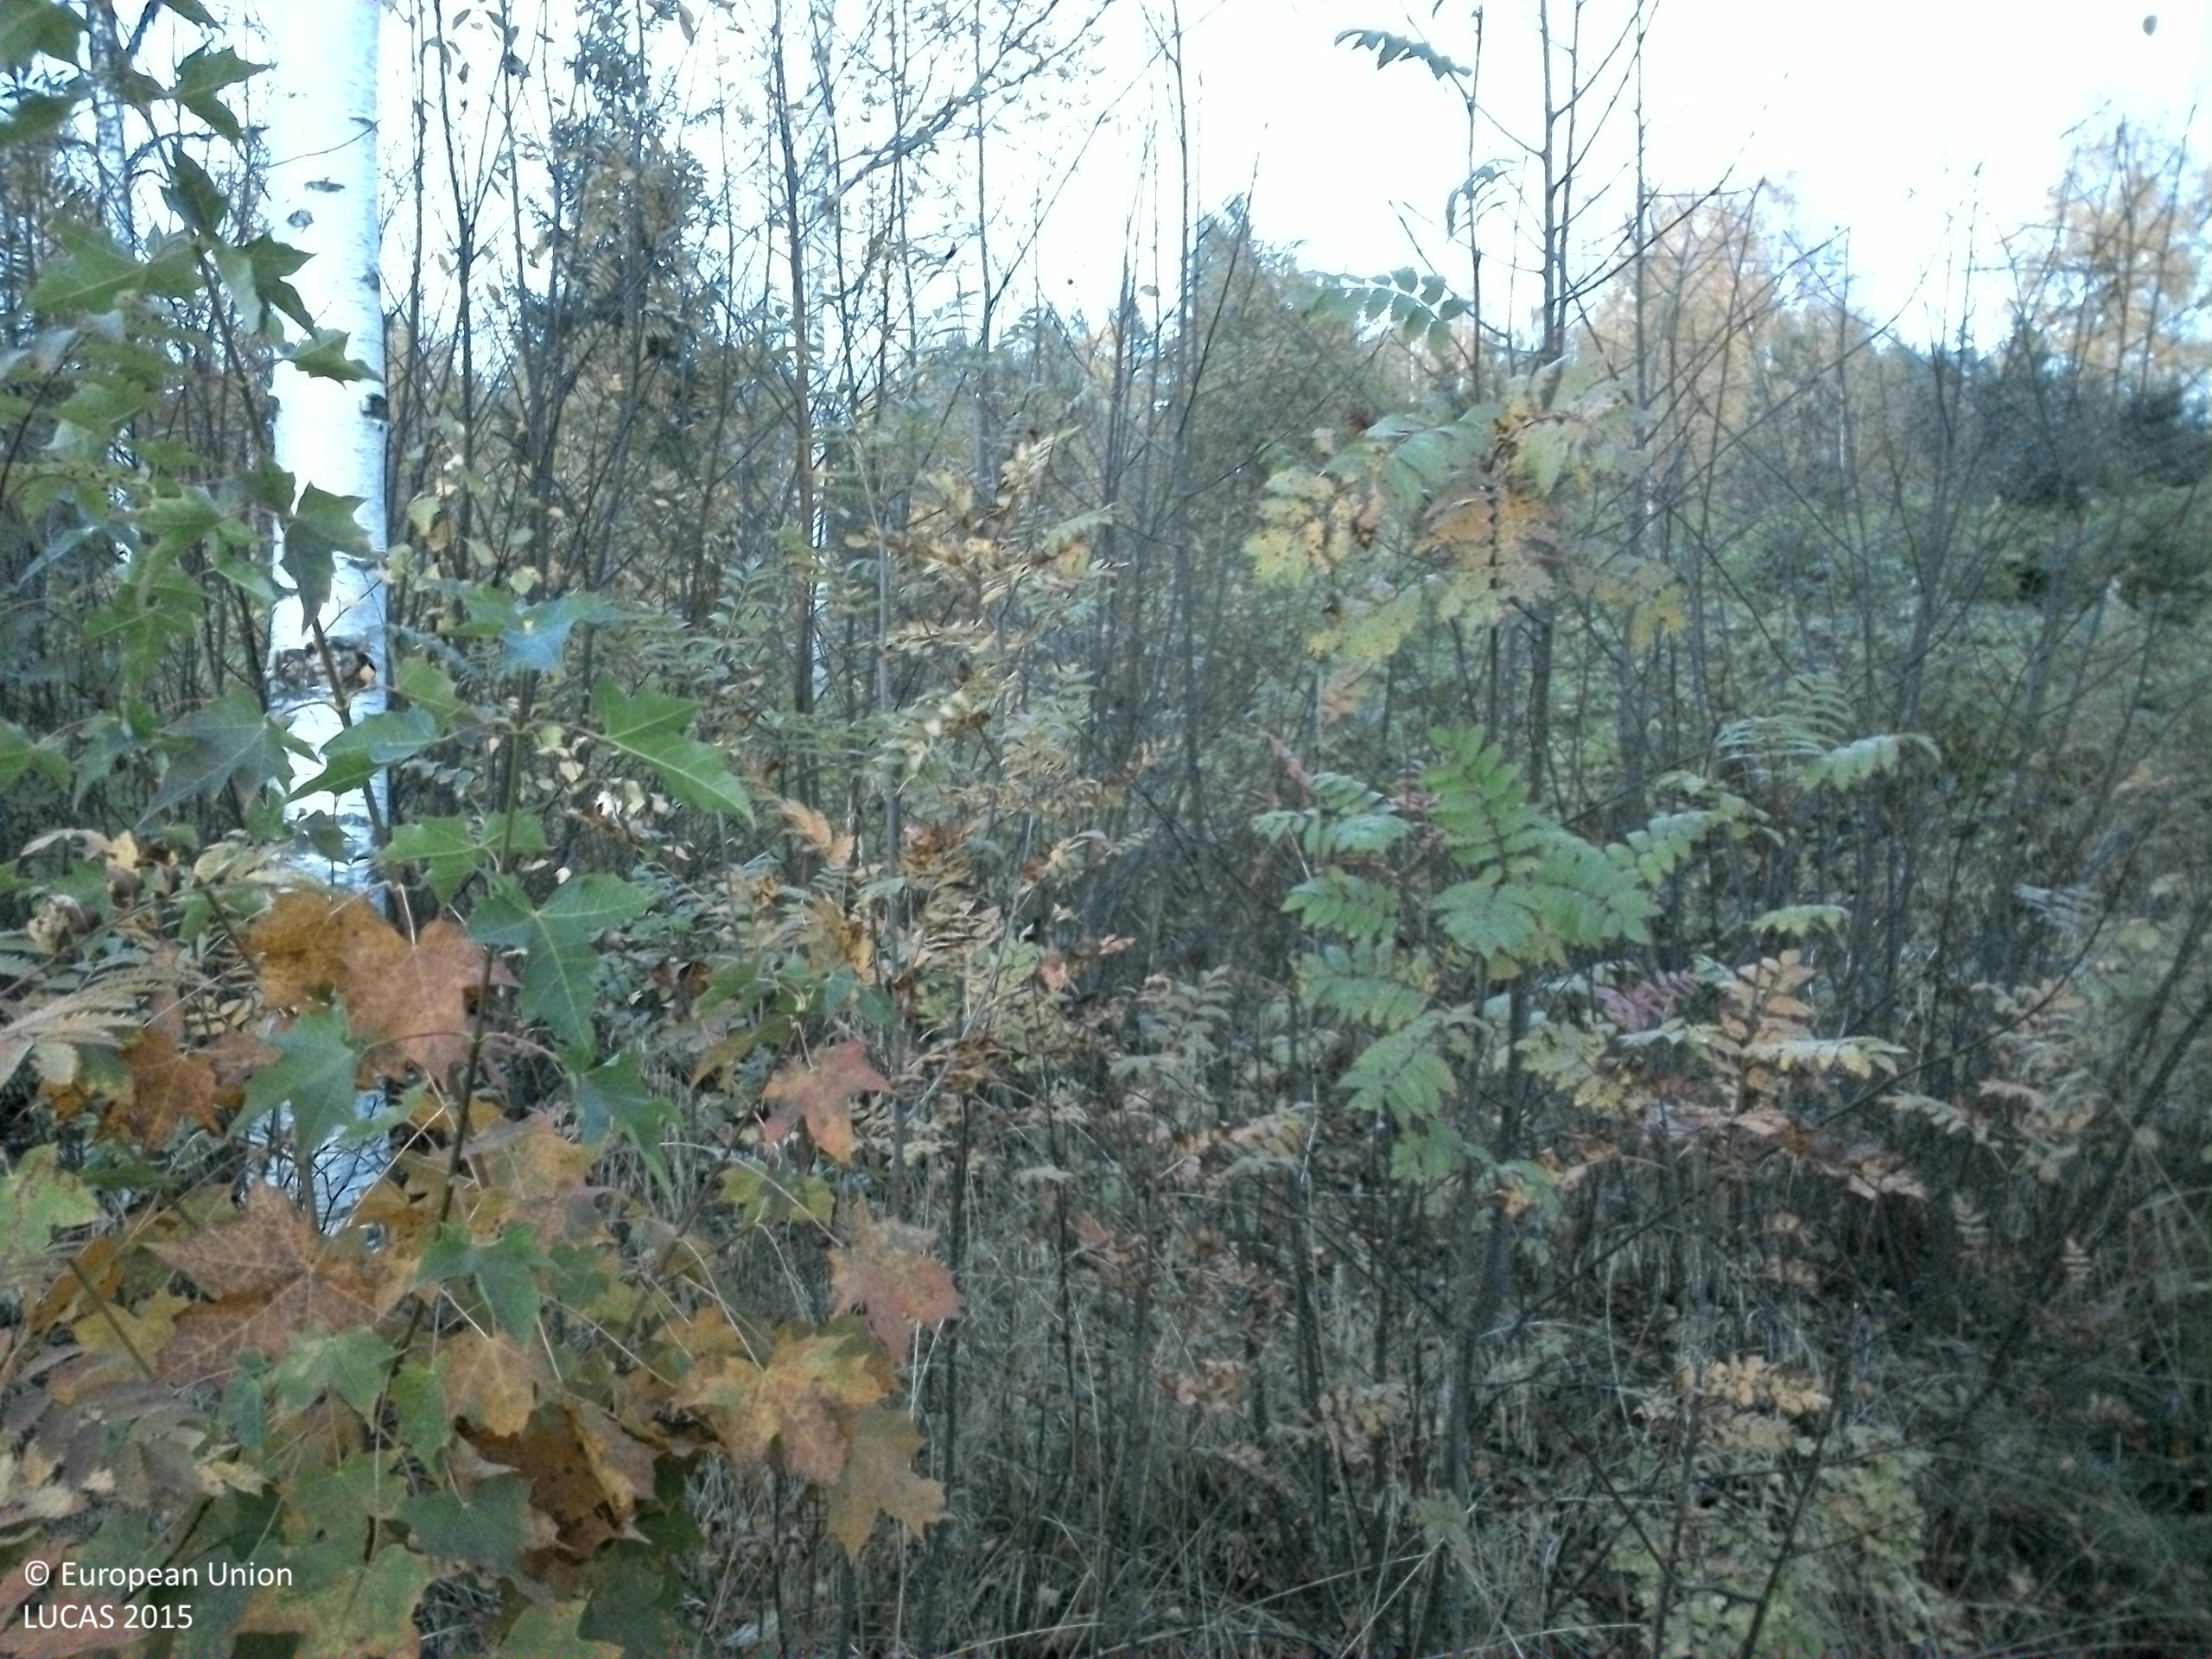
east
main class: Woodland
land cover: Broadleaved woodland
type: boreal forest
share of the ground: 10 - 25 %
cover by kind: shrubs 45 %, herbaceous plants 30 %, broadleaved forest trees 25 %
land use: Forestry
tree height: > 5 m
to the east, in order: Broadleaved woodland; Rocks and stones; Broadleaved woodland; Dry stone walls; Electric lines; Grassland with sparse tree/shrub cover; Paved roads, cycling and walking lanes; Grassland without tree/shrub cover; Ditches and canals; Grassland without tree/shrub cover; Ditches and canals; Grassland without tree/shrub cover; Electric lines; Pine dominated mixed woodland; Shrubland with sparse tree cover; Artificial constructions; Shrubland with sparse tree cover; Dry stone walls; Broadleaved woodland
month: October
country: SE
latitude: 61.1894
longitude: 15.1008
